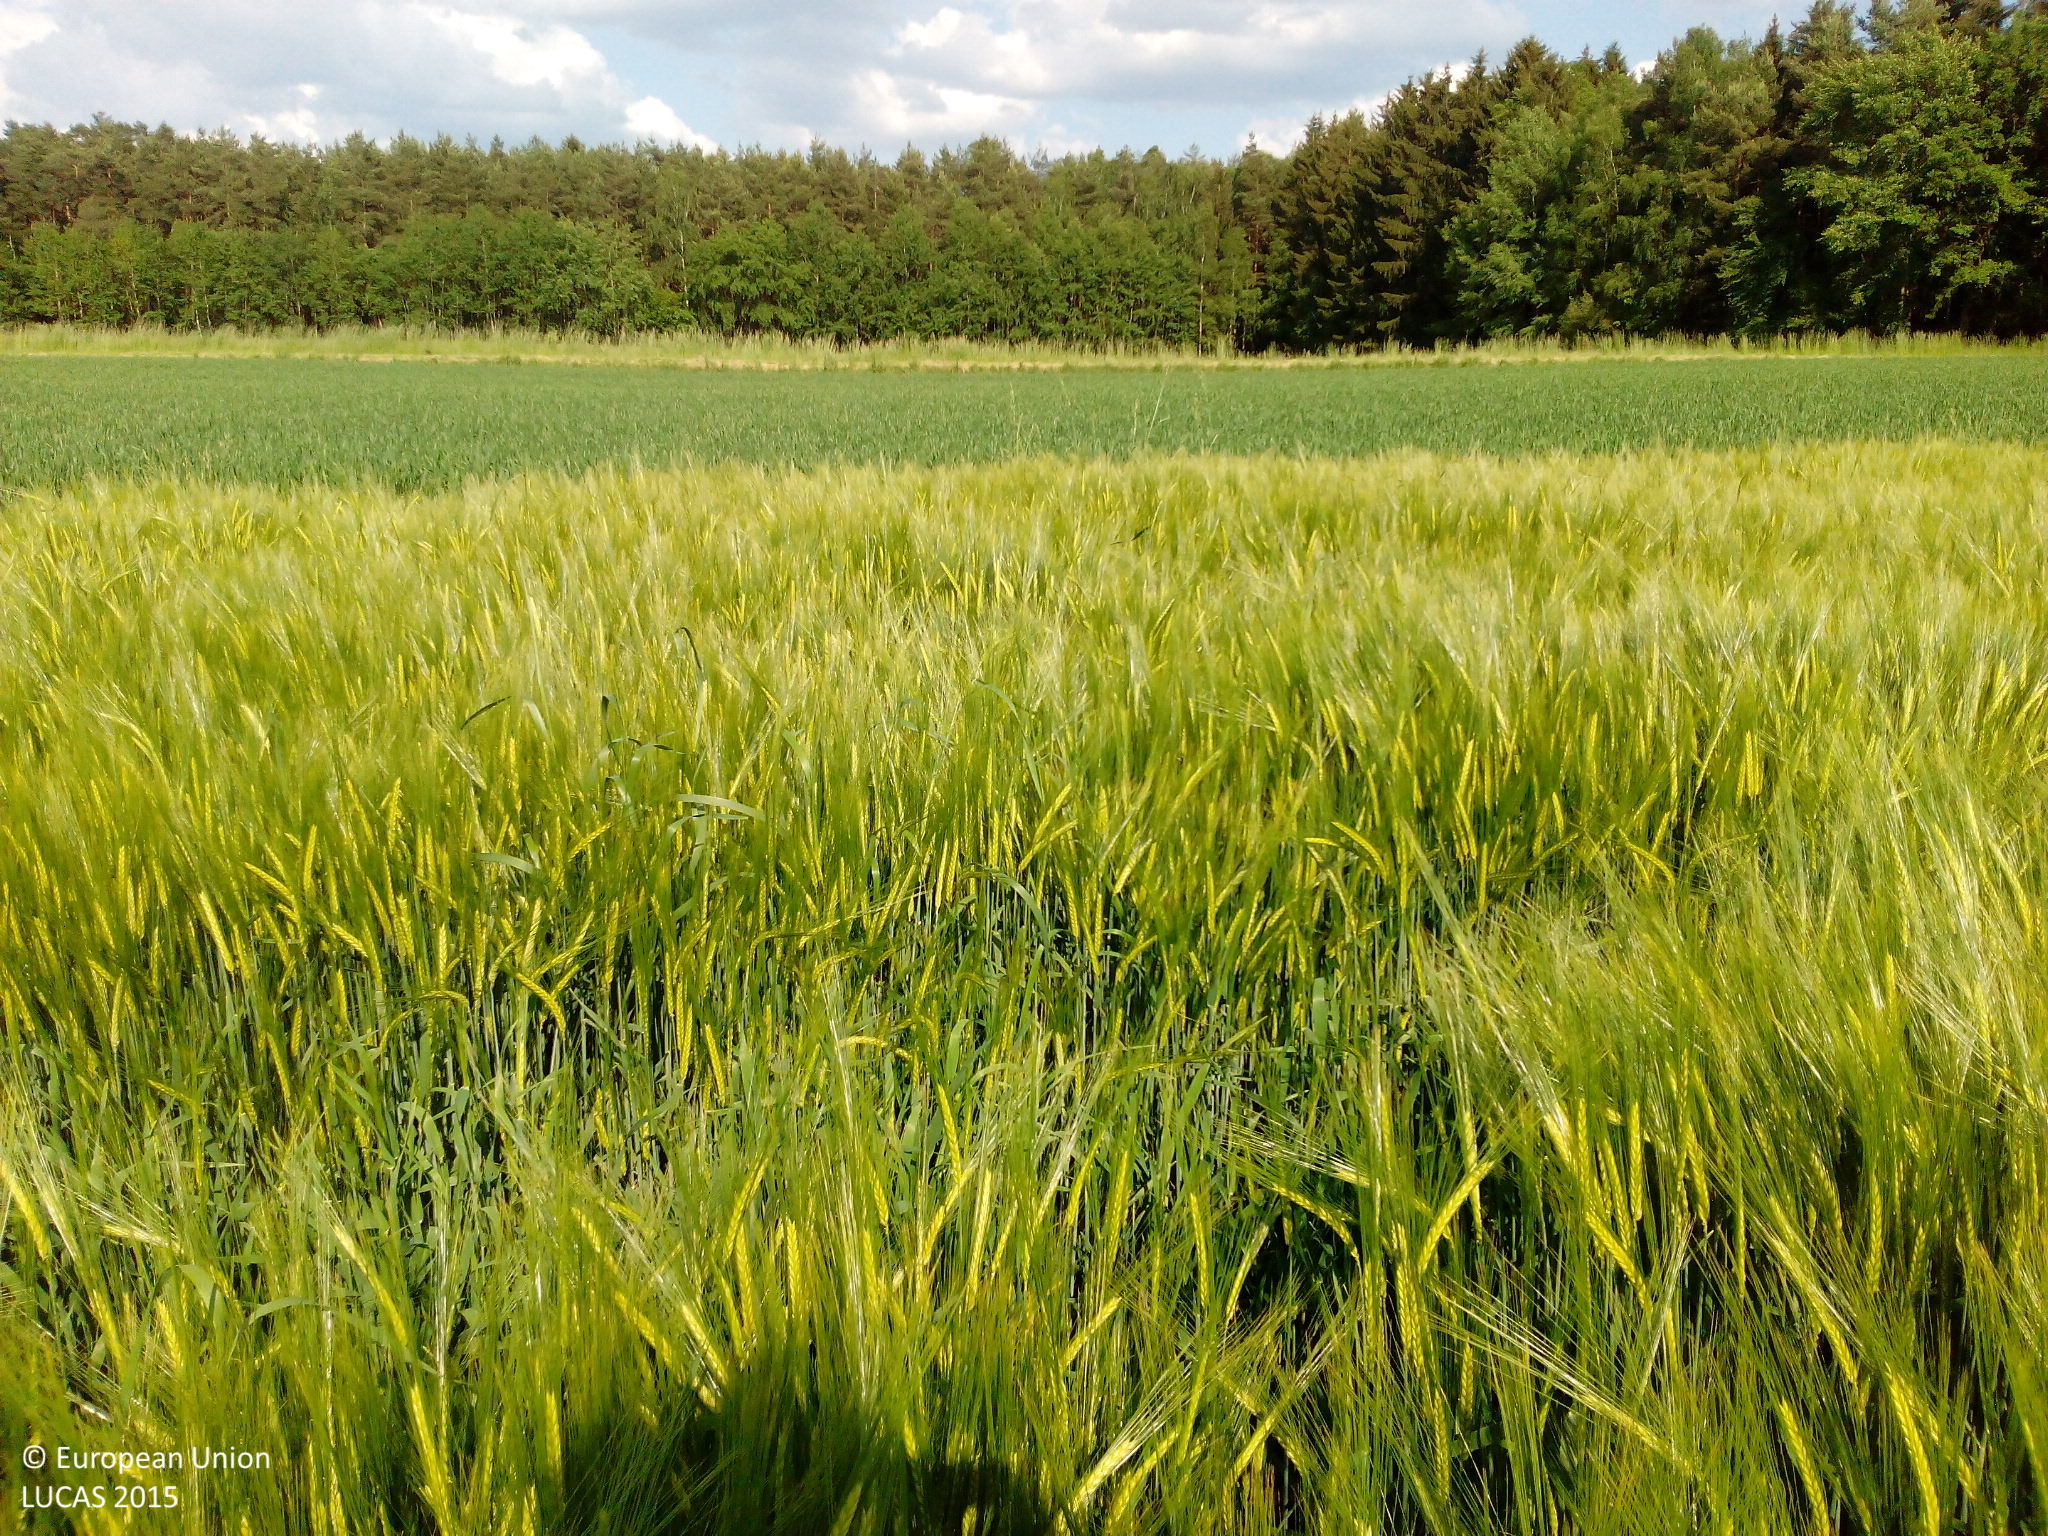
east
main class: Cropland
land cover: Barley
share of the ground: > 75 %
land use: Agriculture (excluding fallow land and kitchen gardens)
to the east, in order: Barley; Ditches and canals; Grass margins; Common wheat; Grass margins; Tracks; Other leguminous and mixtures for fodder; Grassland without tree/shrub cover; Broadleaved woodland; Ditches and canals; Pine dominated coniferous woodland; Tracks; Pine dominated mixed woodland; Tracks; Pine dominated coniferous woodland
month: June
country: DE
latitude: 48.8158
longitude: 12.0829
